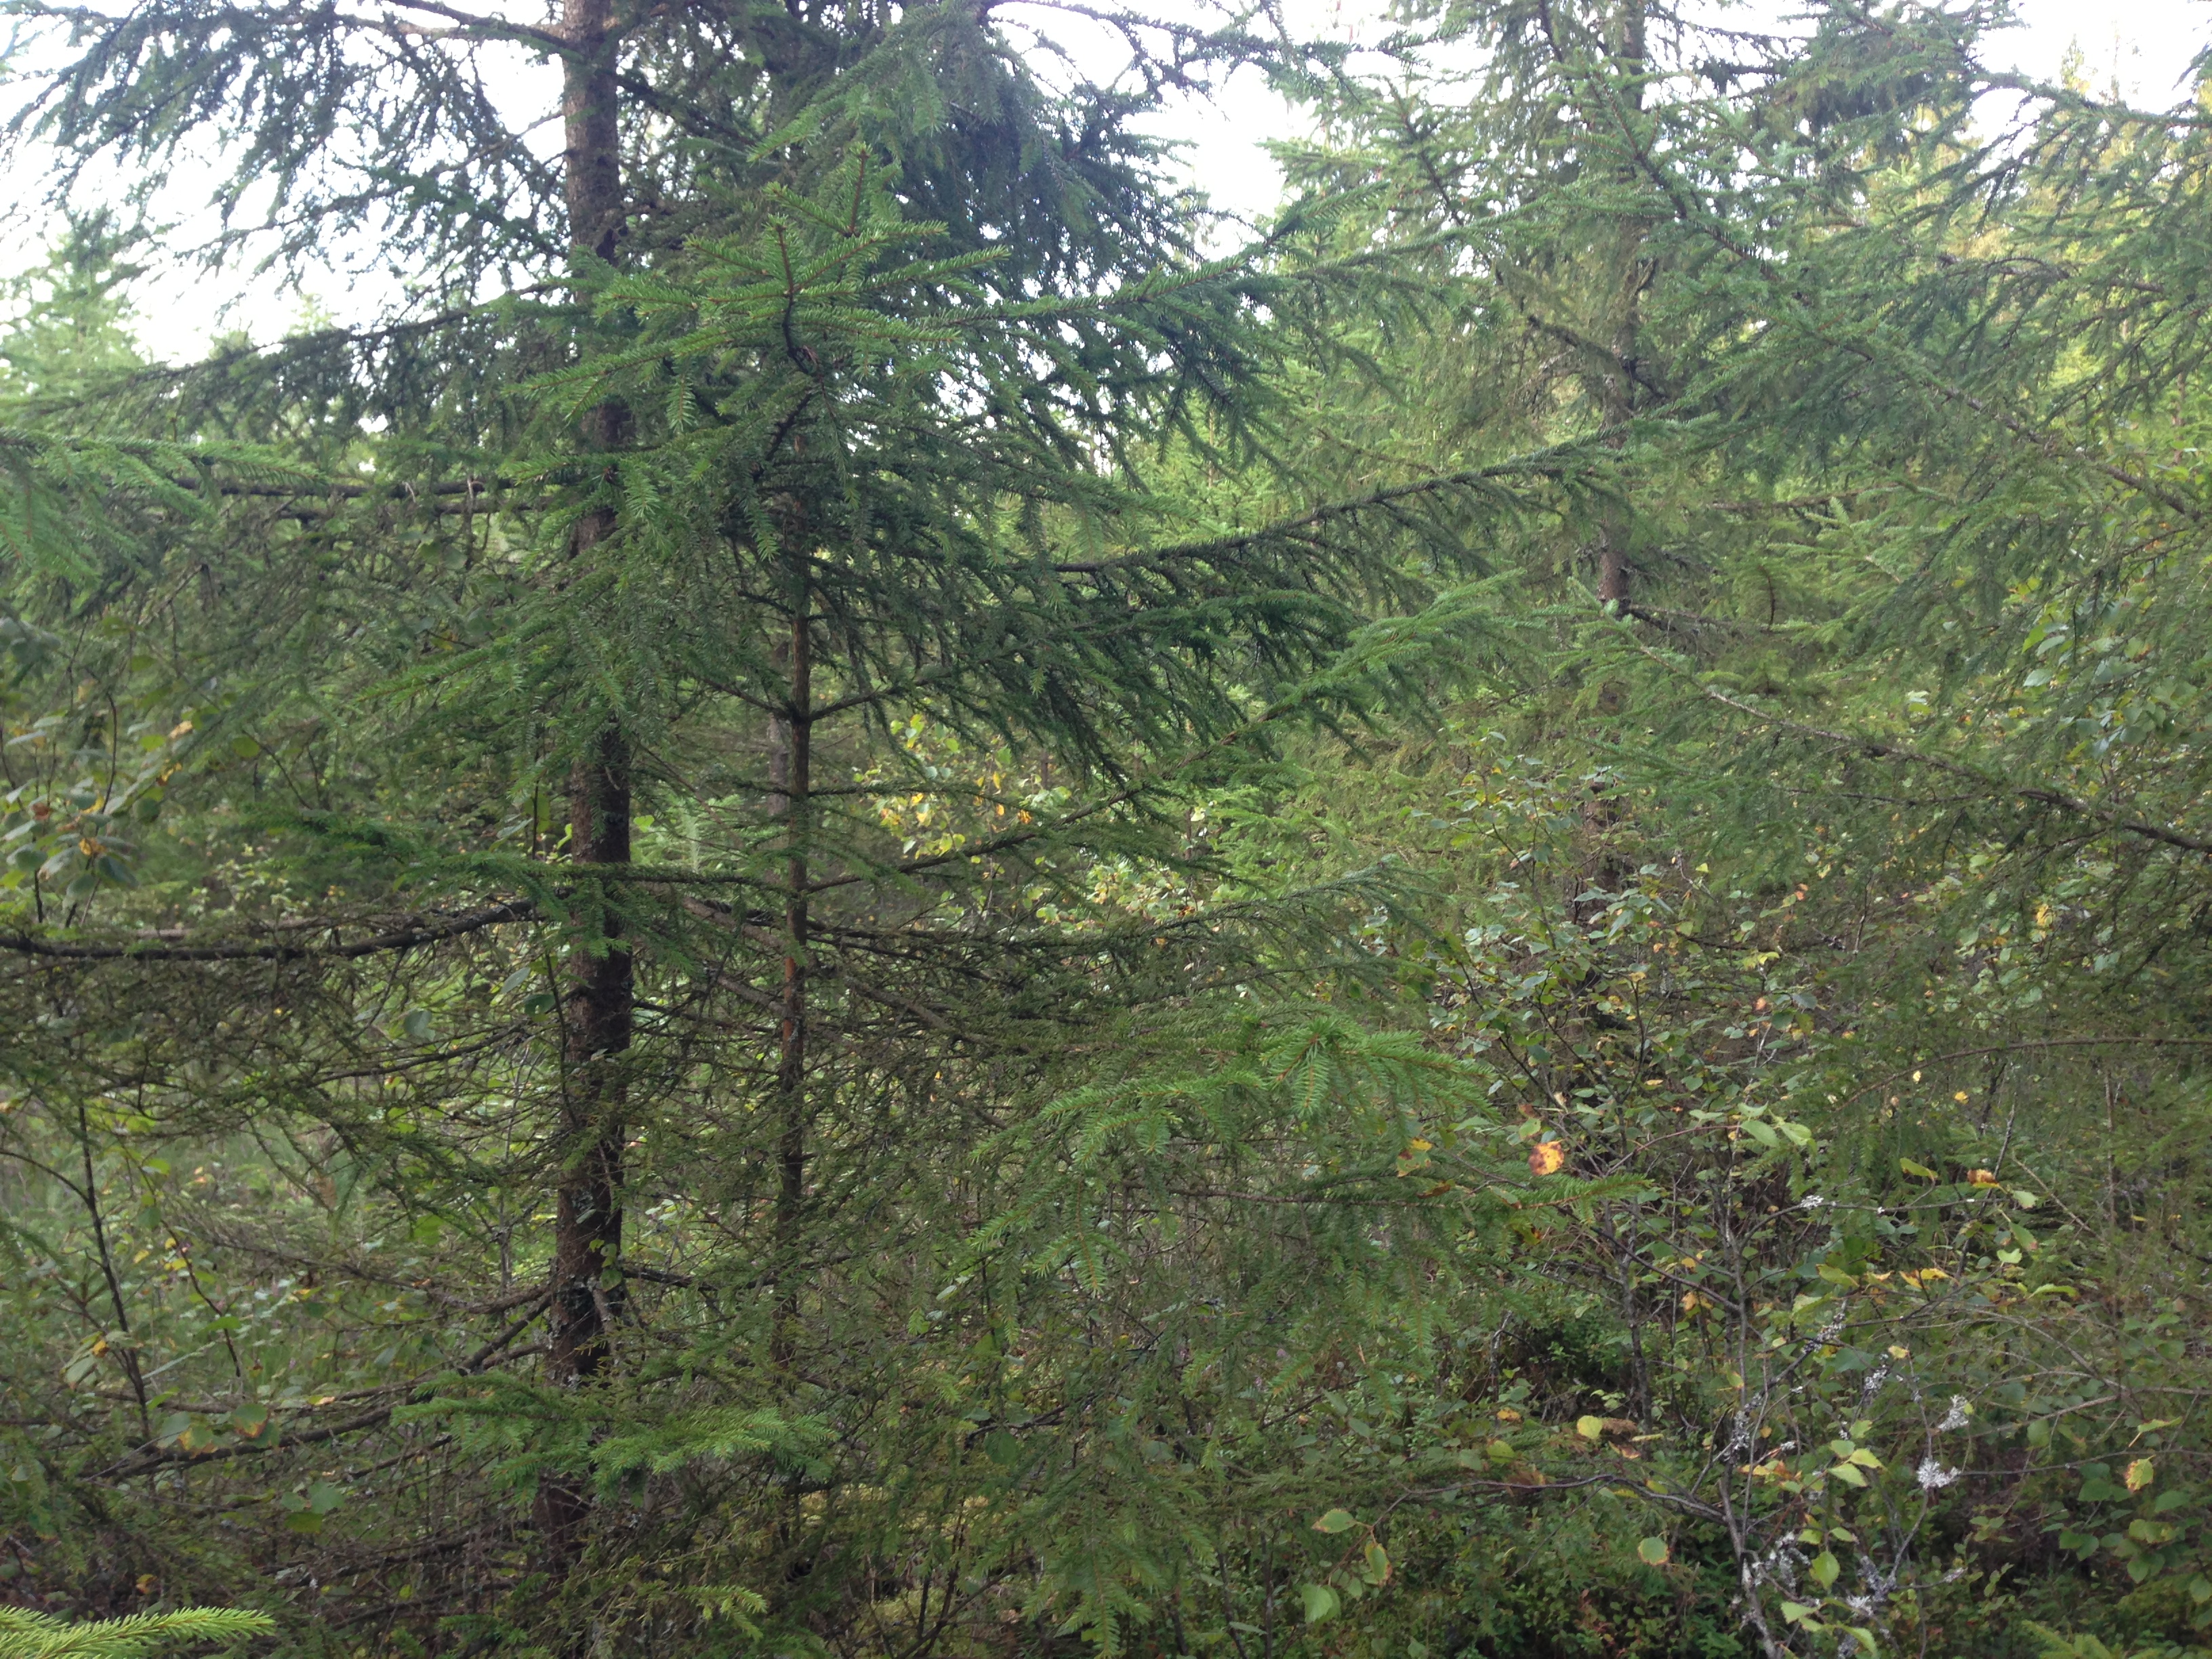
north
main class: Woodland
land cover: Spruce dominated mixed woodland
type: boreal forest
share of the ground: > 75 %
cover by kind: coniferous forest trees 60 %, broadleaved forest trees 20 %, shrubs 20 %
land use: Forestry
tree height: > 5 m
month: September
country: SE
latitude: 57.1207
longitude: 13.1508
